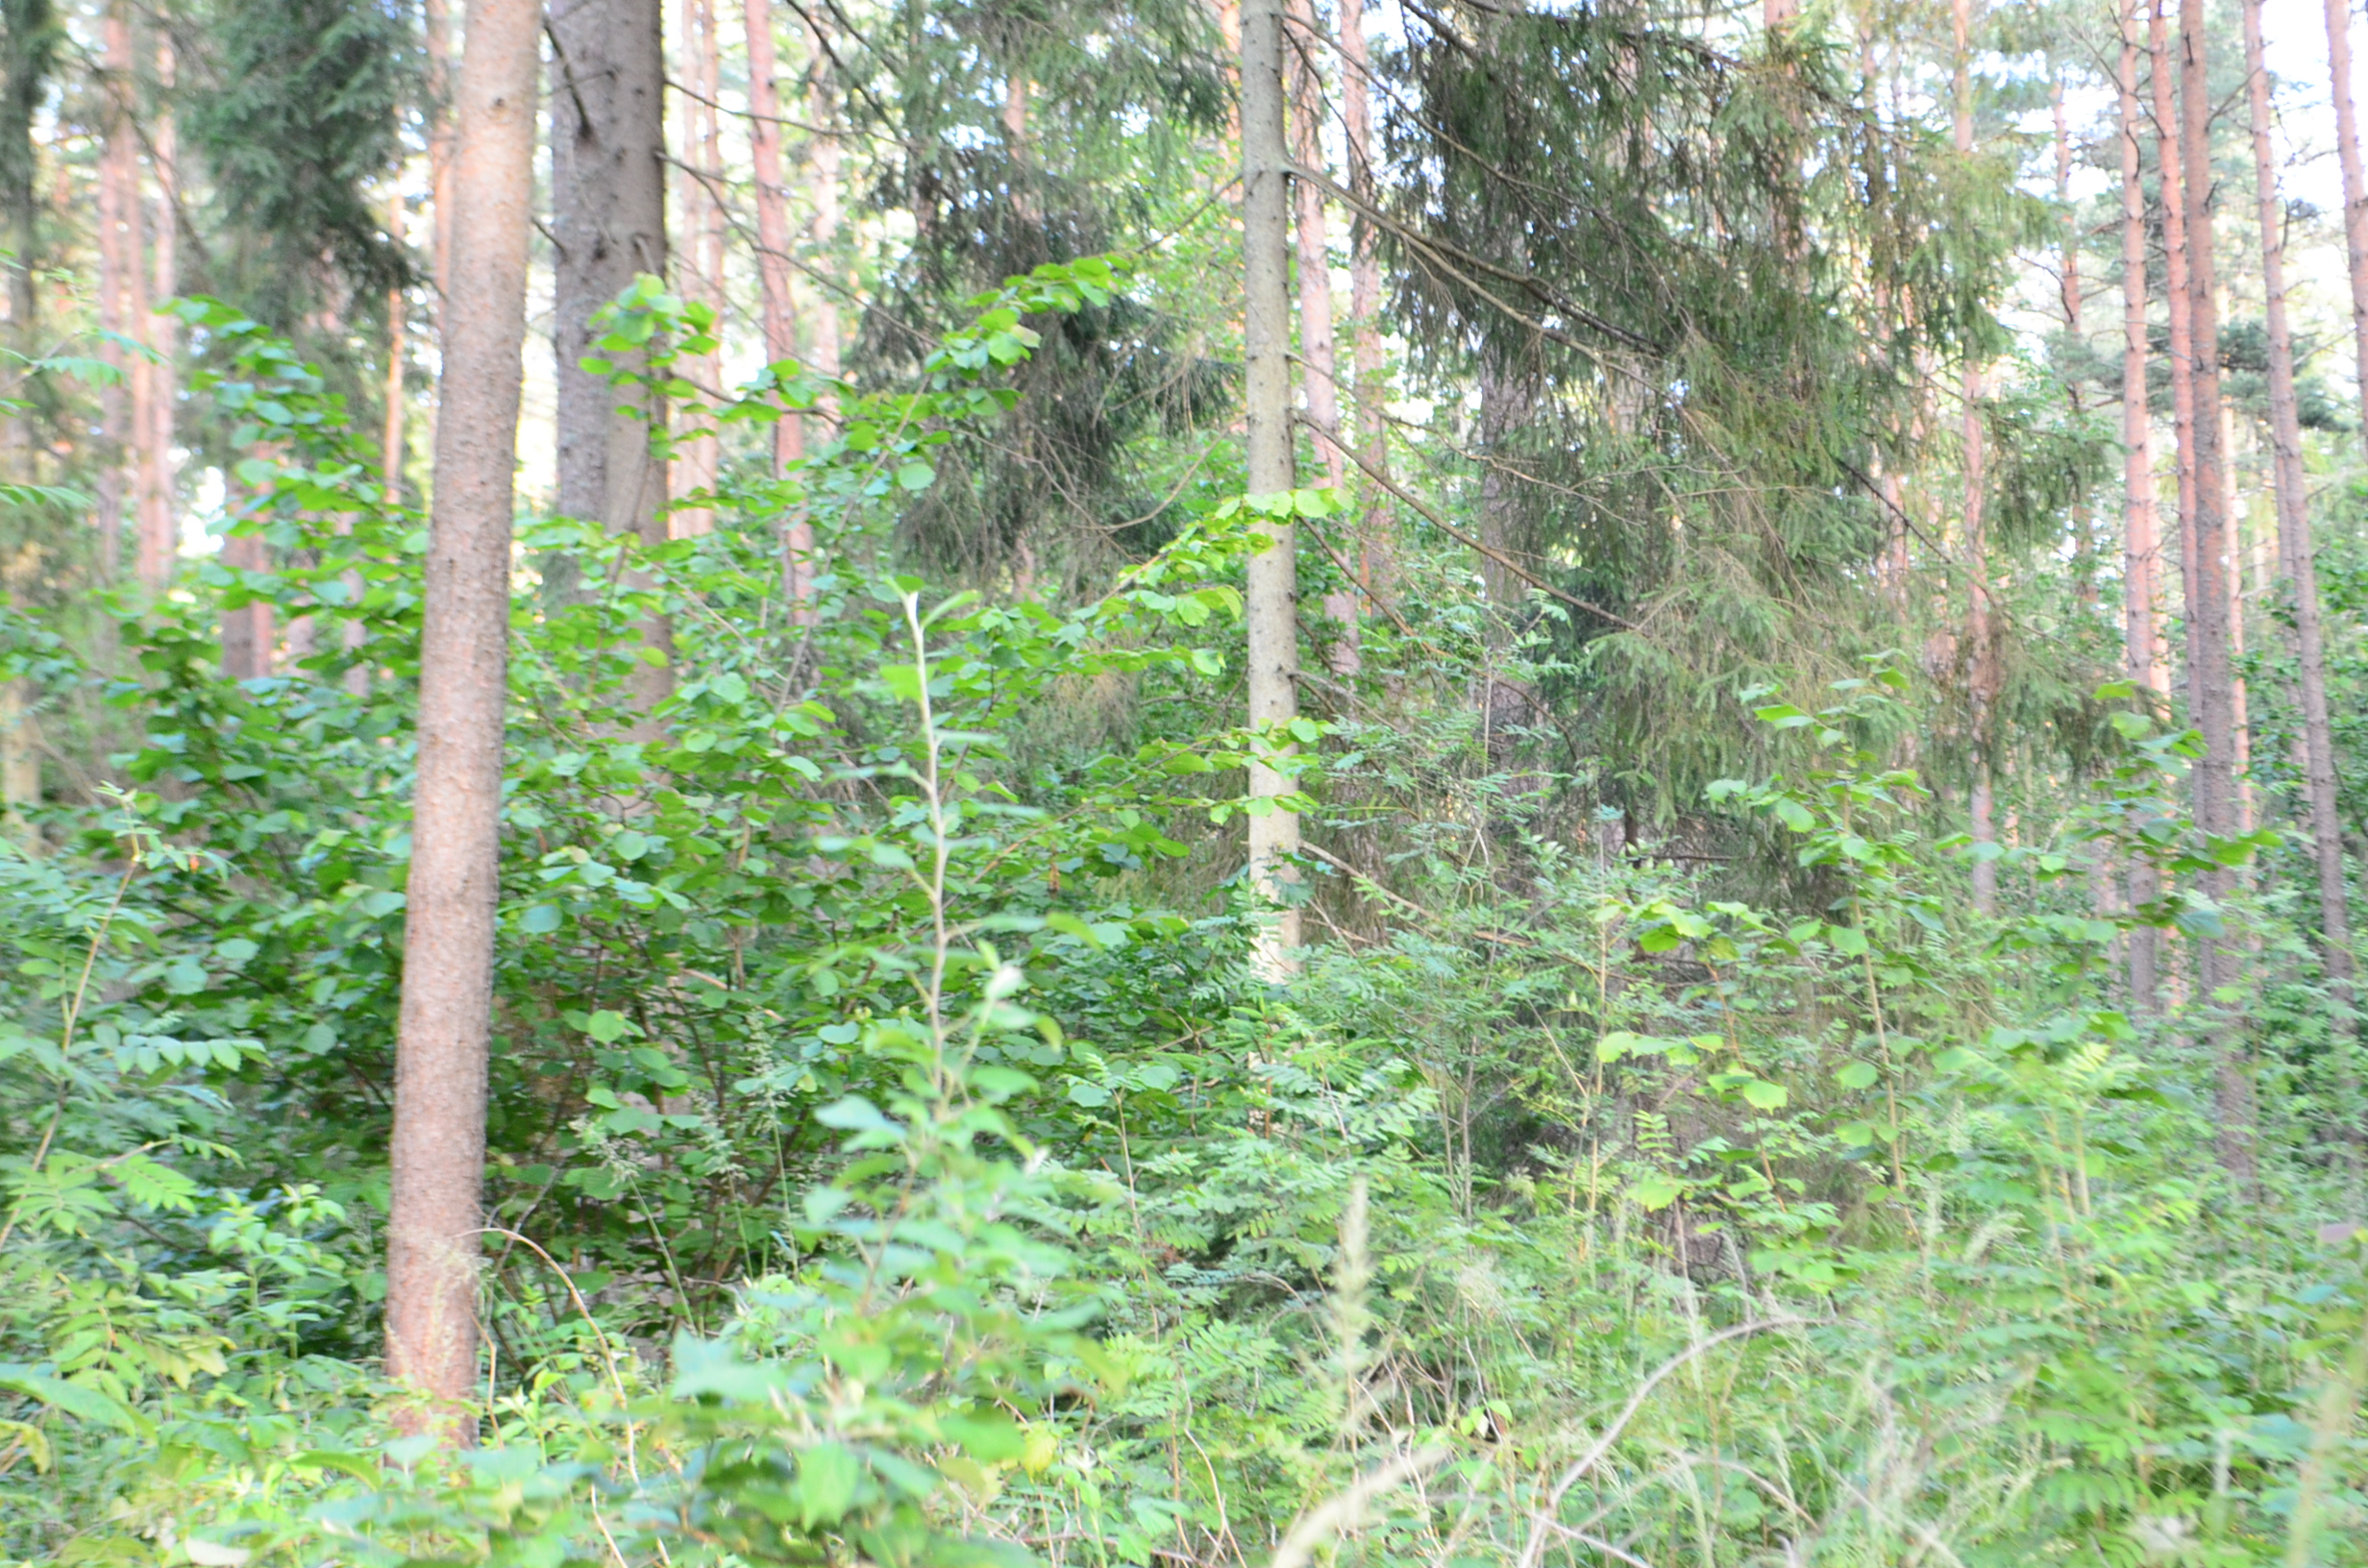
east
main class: Woodland
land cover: Other coniferous woodland
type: hemiboreal forest and nemoral coniferous forest and mixed broadleaved-coniferous forest
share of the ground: > 75 %
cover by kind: coniferous forest trees 75 %, shrubs 10 %, herbaceous plants 10 %, lichens and mosses 5 %
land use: Forestry
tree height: > 5 m
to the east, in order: Other coniferous woodland
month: July
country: LV
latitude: 57.3847
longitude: 21.8373
